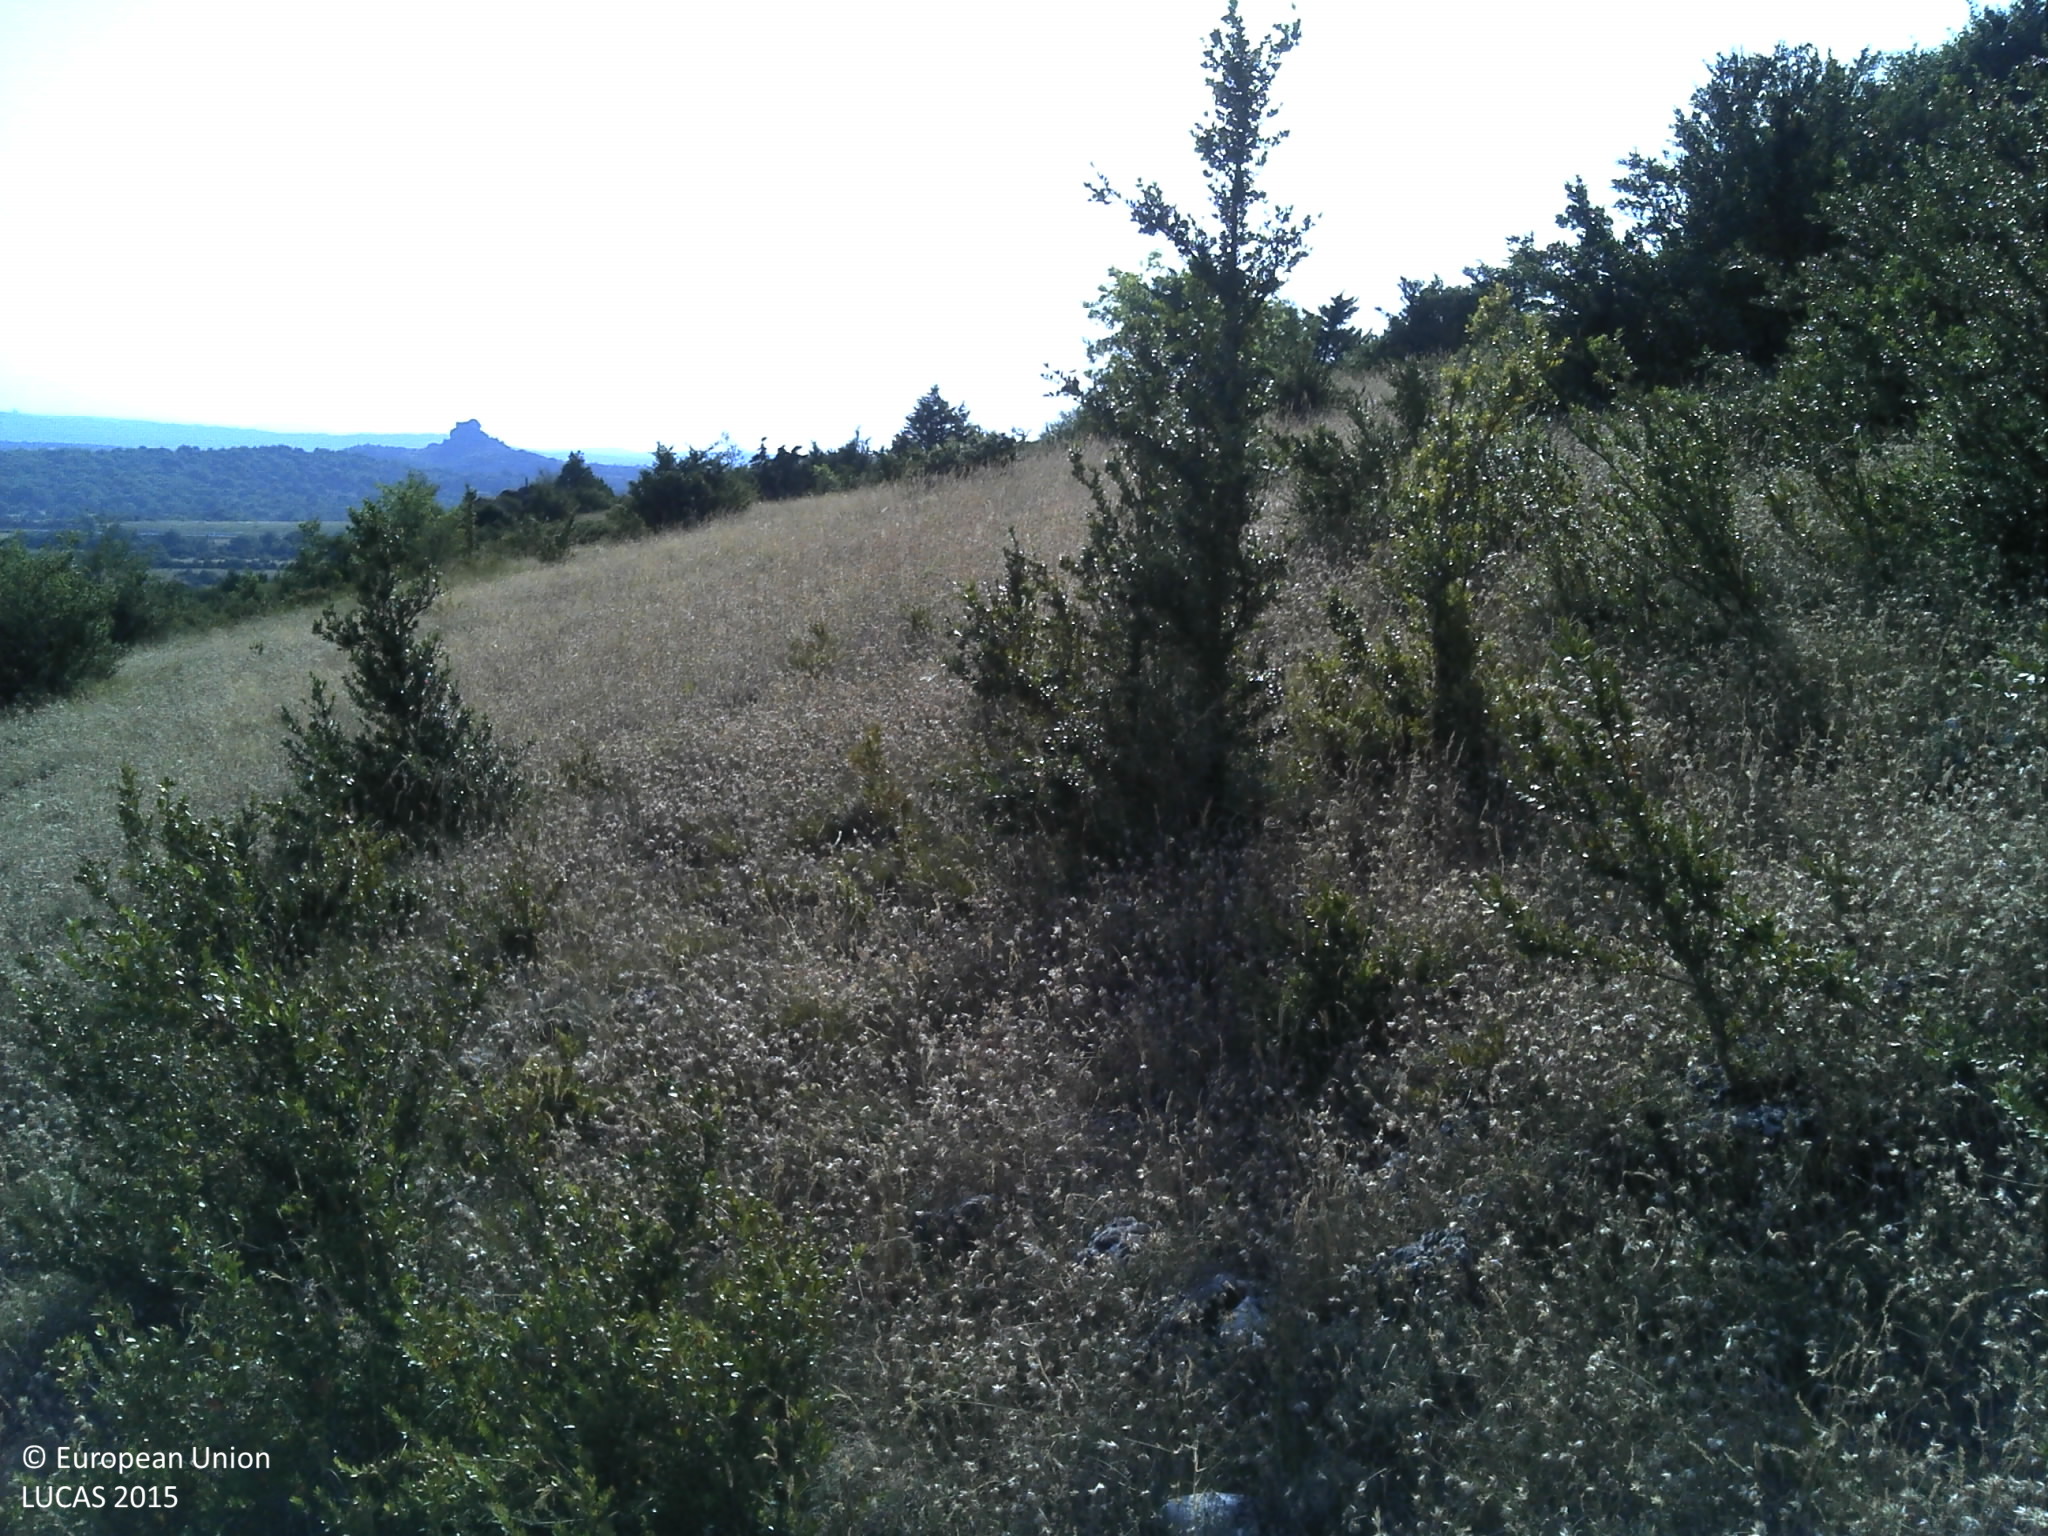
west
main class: Grassland
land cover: Grassland with sparse tree/shrub cover
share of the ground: > 75 %
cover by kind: herbaceous plants 75 %, unconsolidated bare surface 20 %, broadleaved forest trees 5 %
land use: Semi-natural and natural areas not in use
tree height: < 5 m
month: July
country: FR
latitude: 43.8821
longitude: 3.3237
